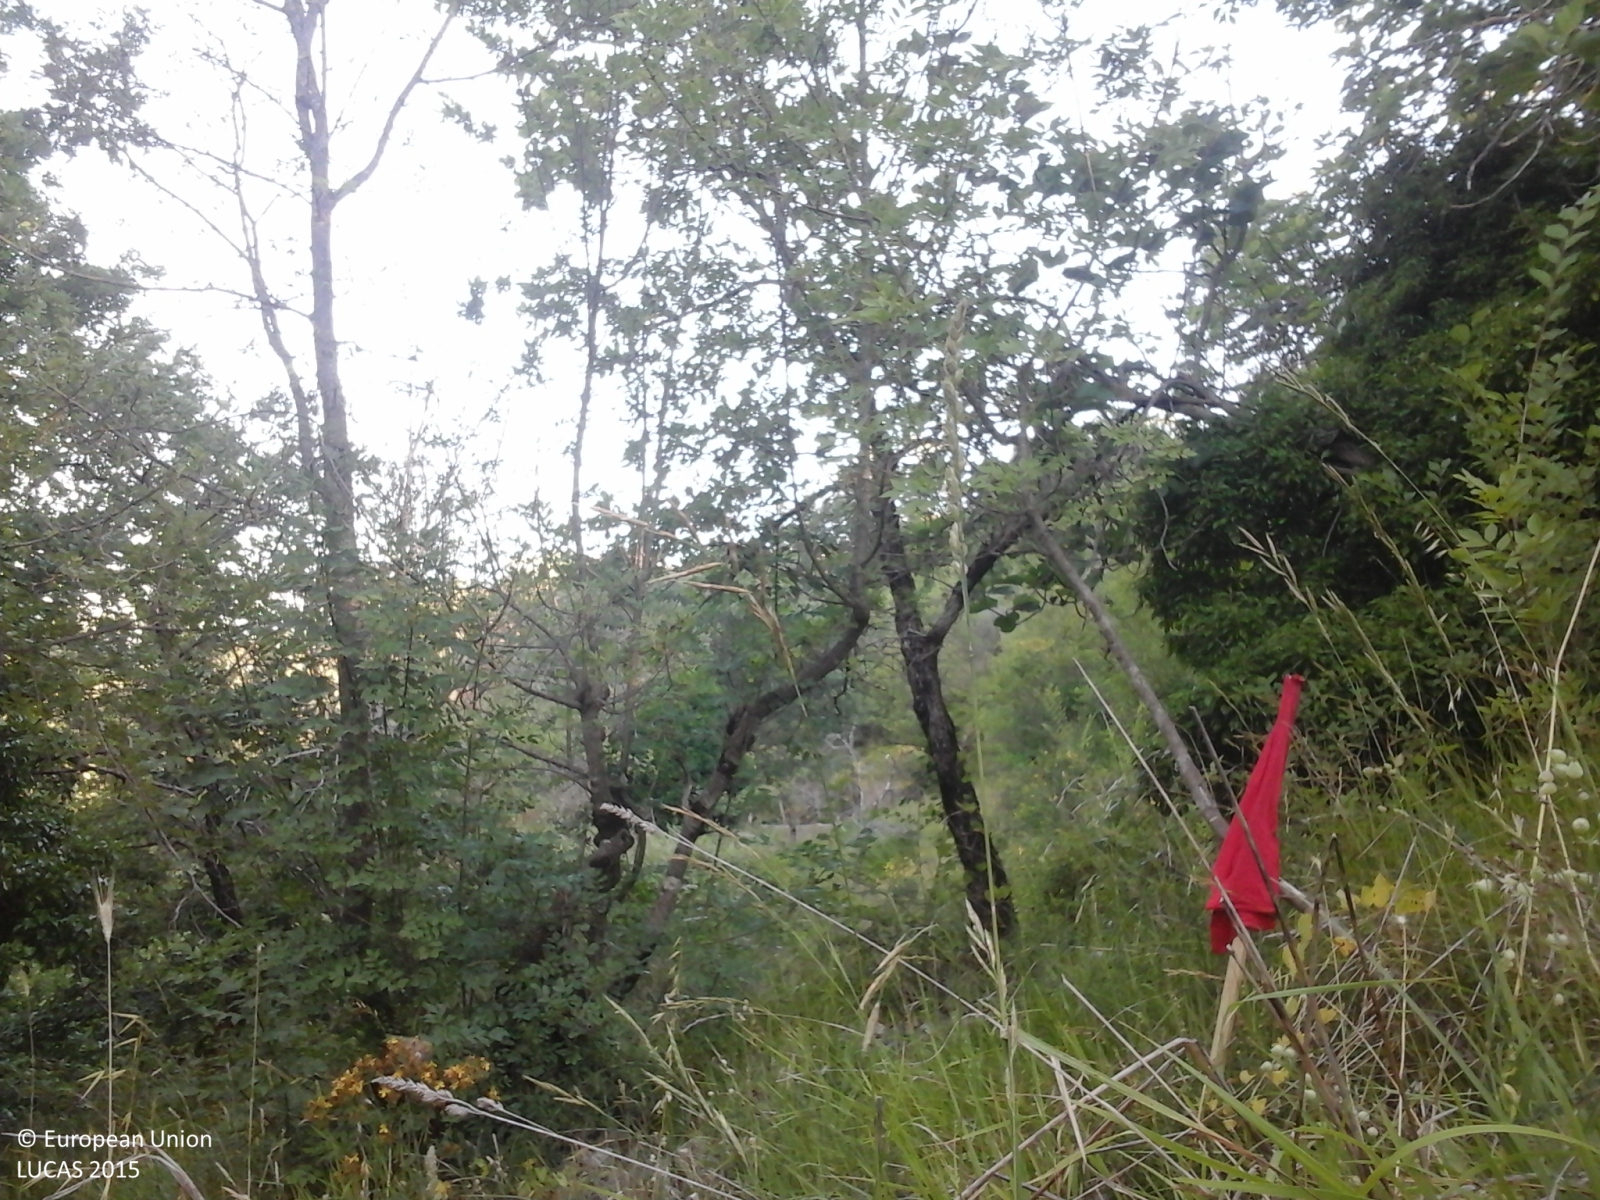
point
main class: Woodland
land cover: Broadleaved woodland
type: thermophilous deciduous forest
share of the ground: > 75 %
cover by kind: broadleaved forest trees 70 %, herbaceous plants 30 %
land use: Semi-natural and natural areas not in use
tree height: > 5 m
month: June
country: IT
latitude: 42.1972
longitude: 12.8844
